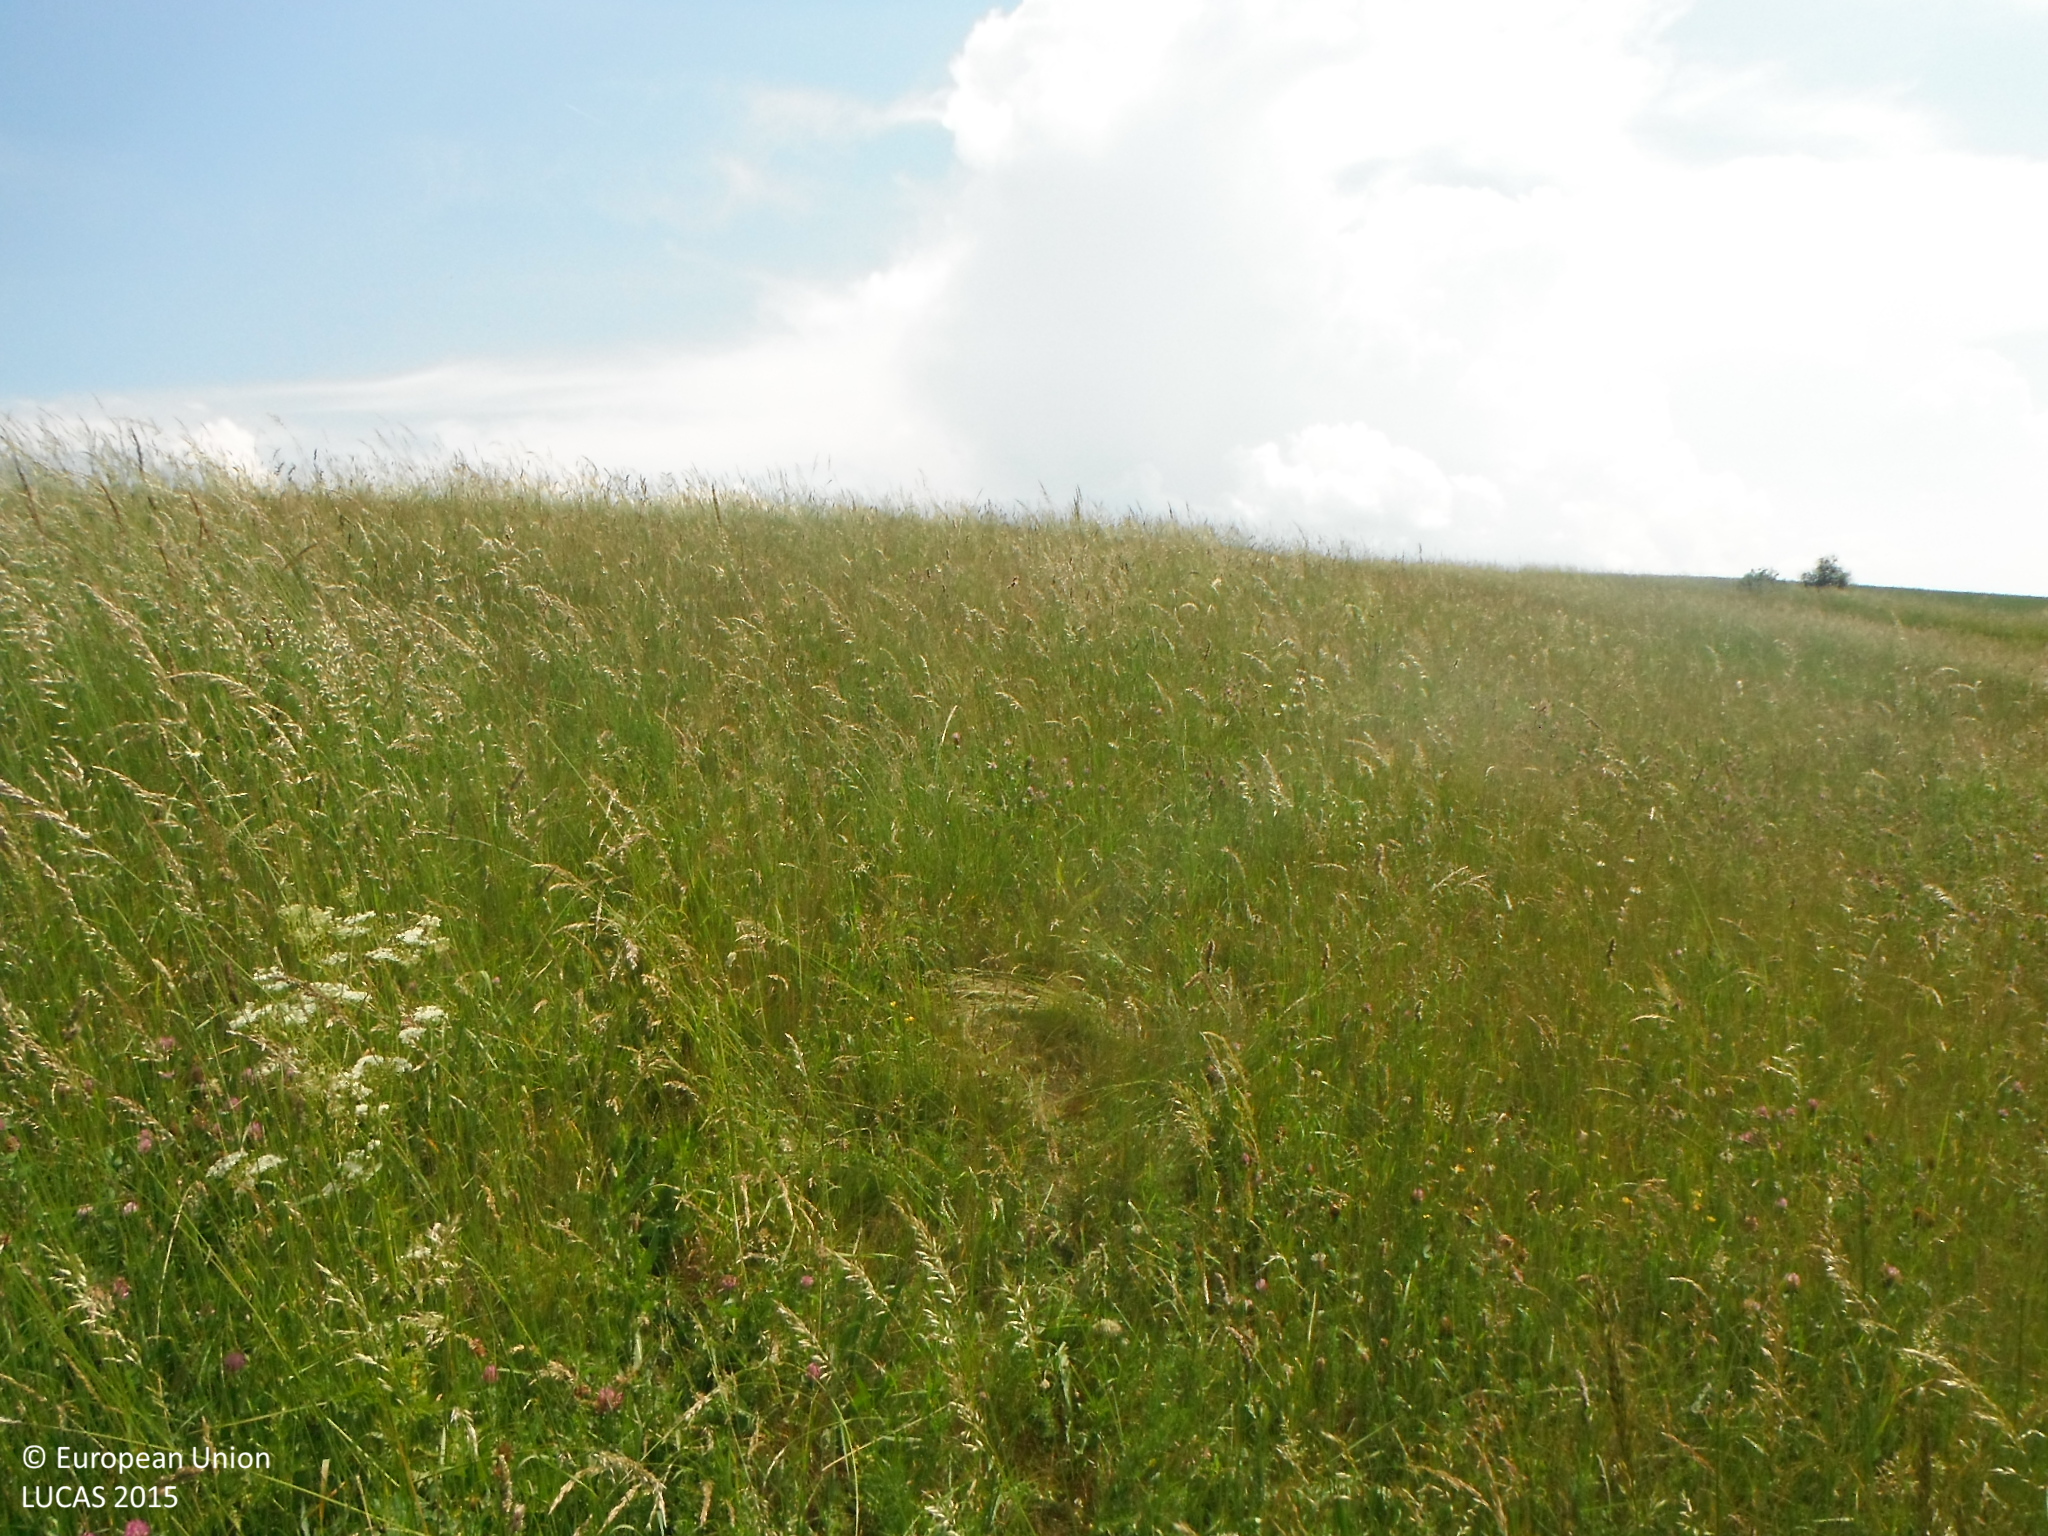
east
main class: Grassland
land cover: Grassland without tree/shrub cover
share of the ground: > 75 %
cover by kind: herbaceous plants 100 %
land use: Agriculture (excluding fallow land and kitchen gardens)
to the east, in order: Grassland without tree/shrub cover; Tracks; Grassland without tree/shrub cover; Common wheat
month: June
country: SK
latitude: 48.7077
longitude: 19.1955
